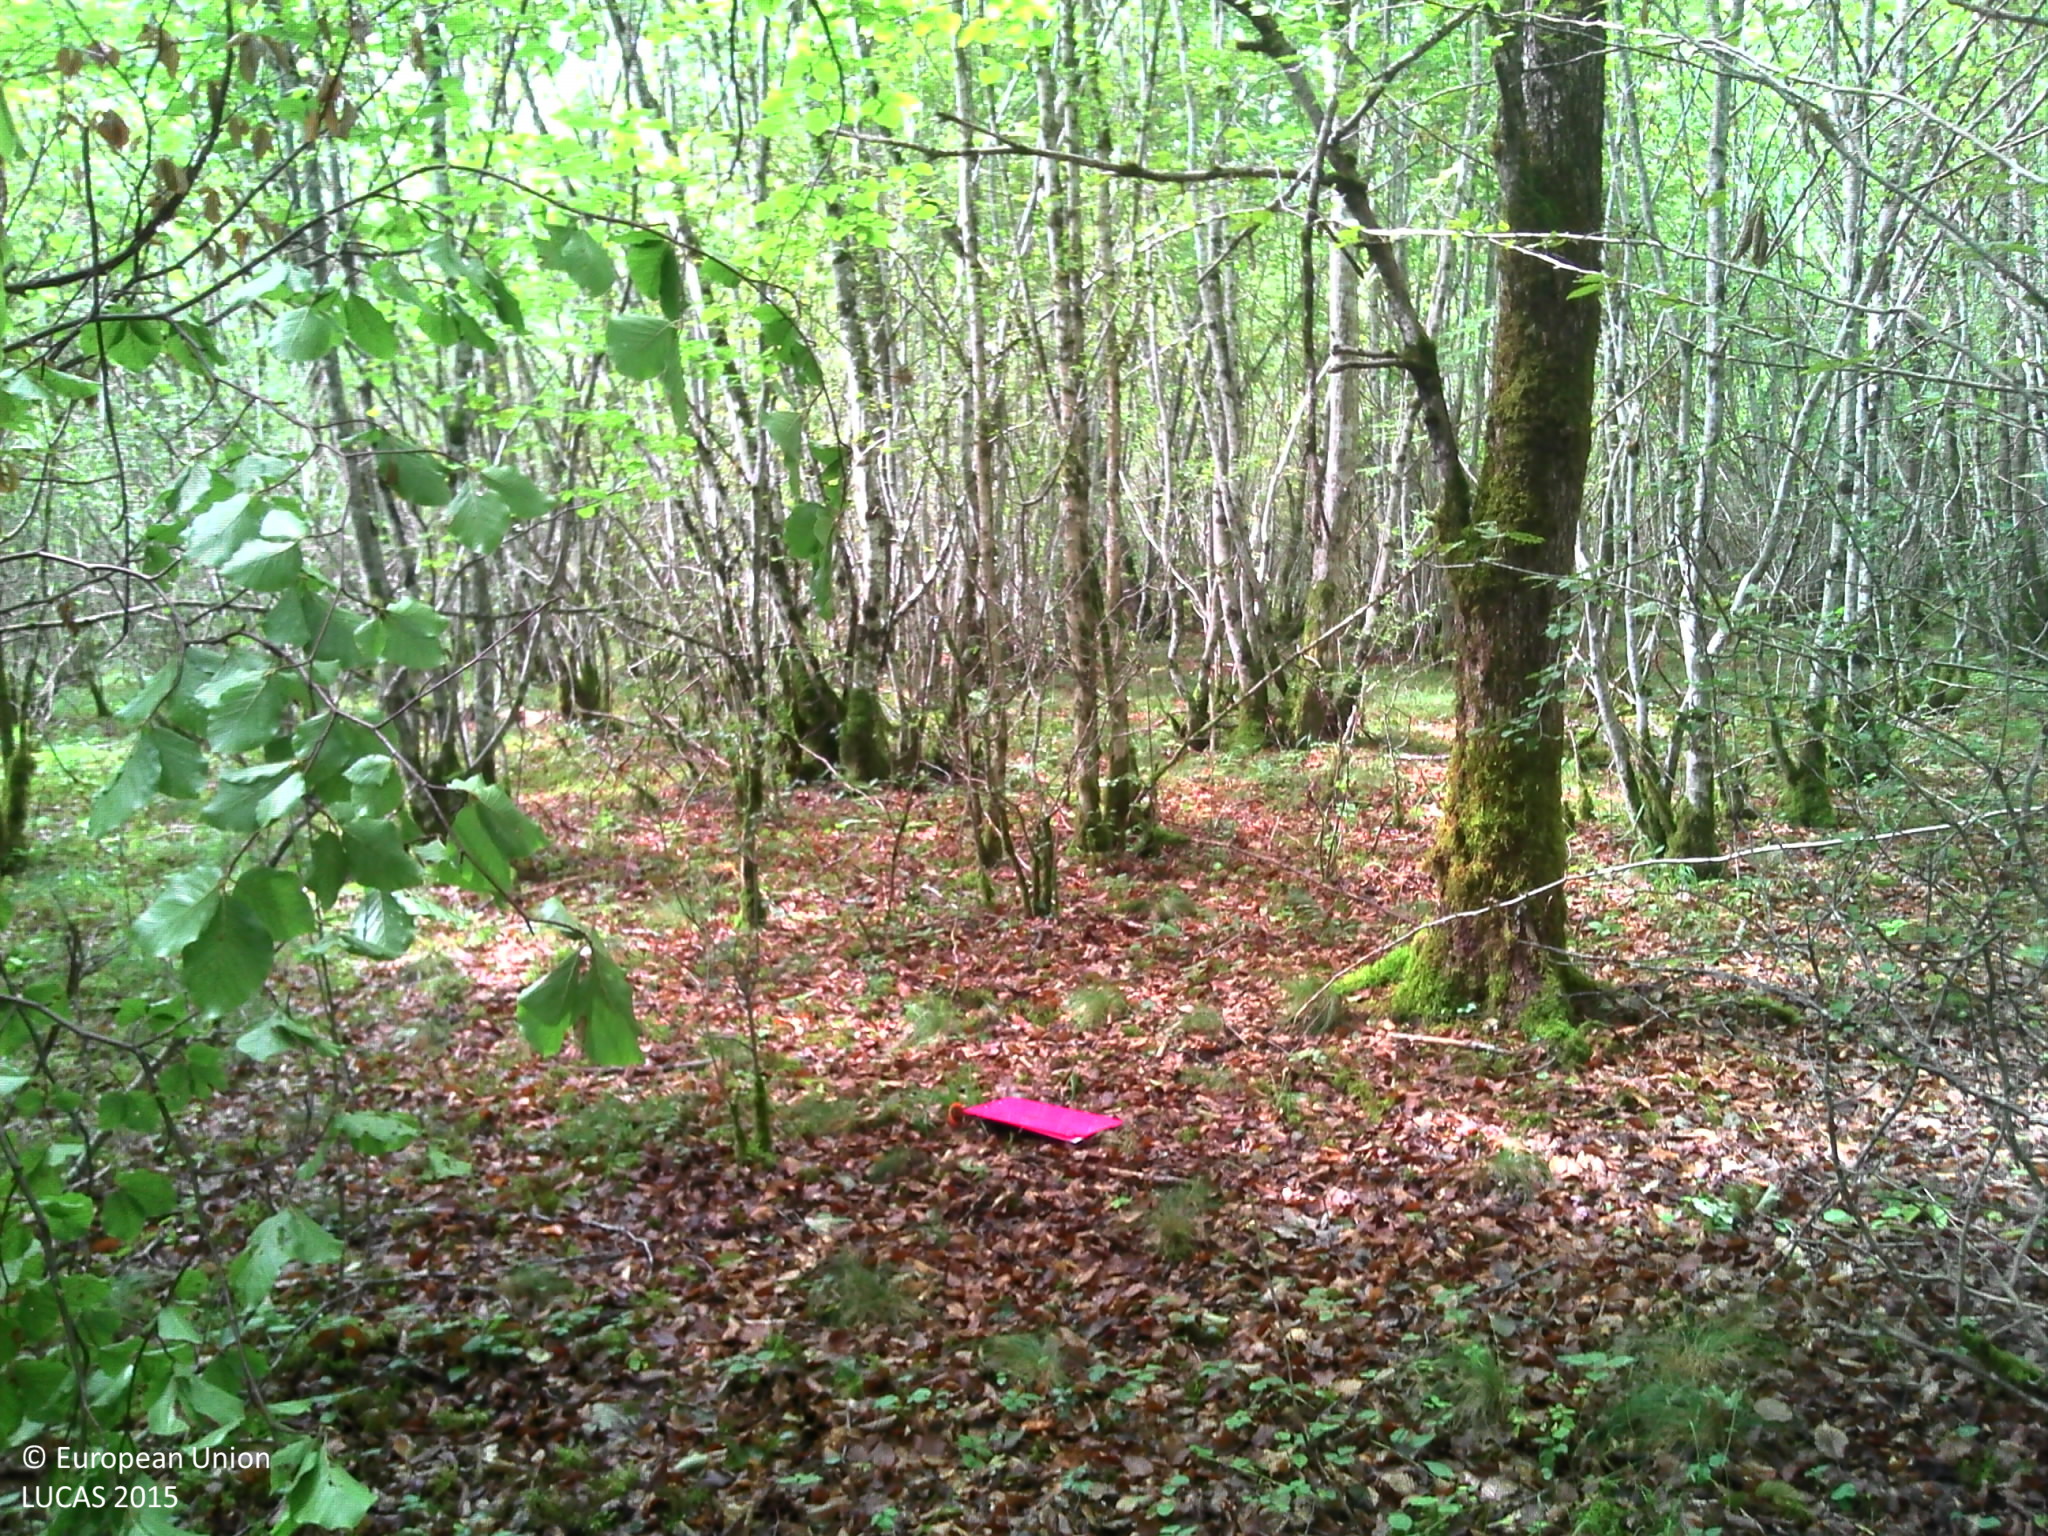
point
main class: Woodland
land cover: Broadleaved woodland
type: mesophytic deciduous forest
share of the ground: > 75 %
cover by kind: broadleaved forest trees 100 %
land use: Forestry
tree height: > 5 m
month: August
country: FR
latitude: 47.3625
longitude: 4.8229
